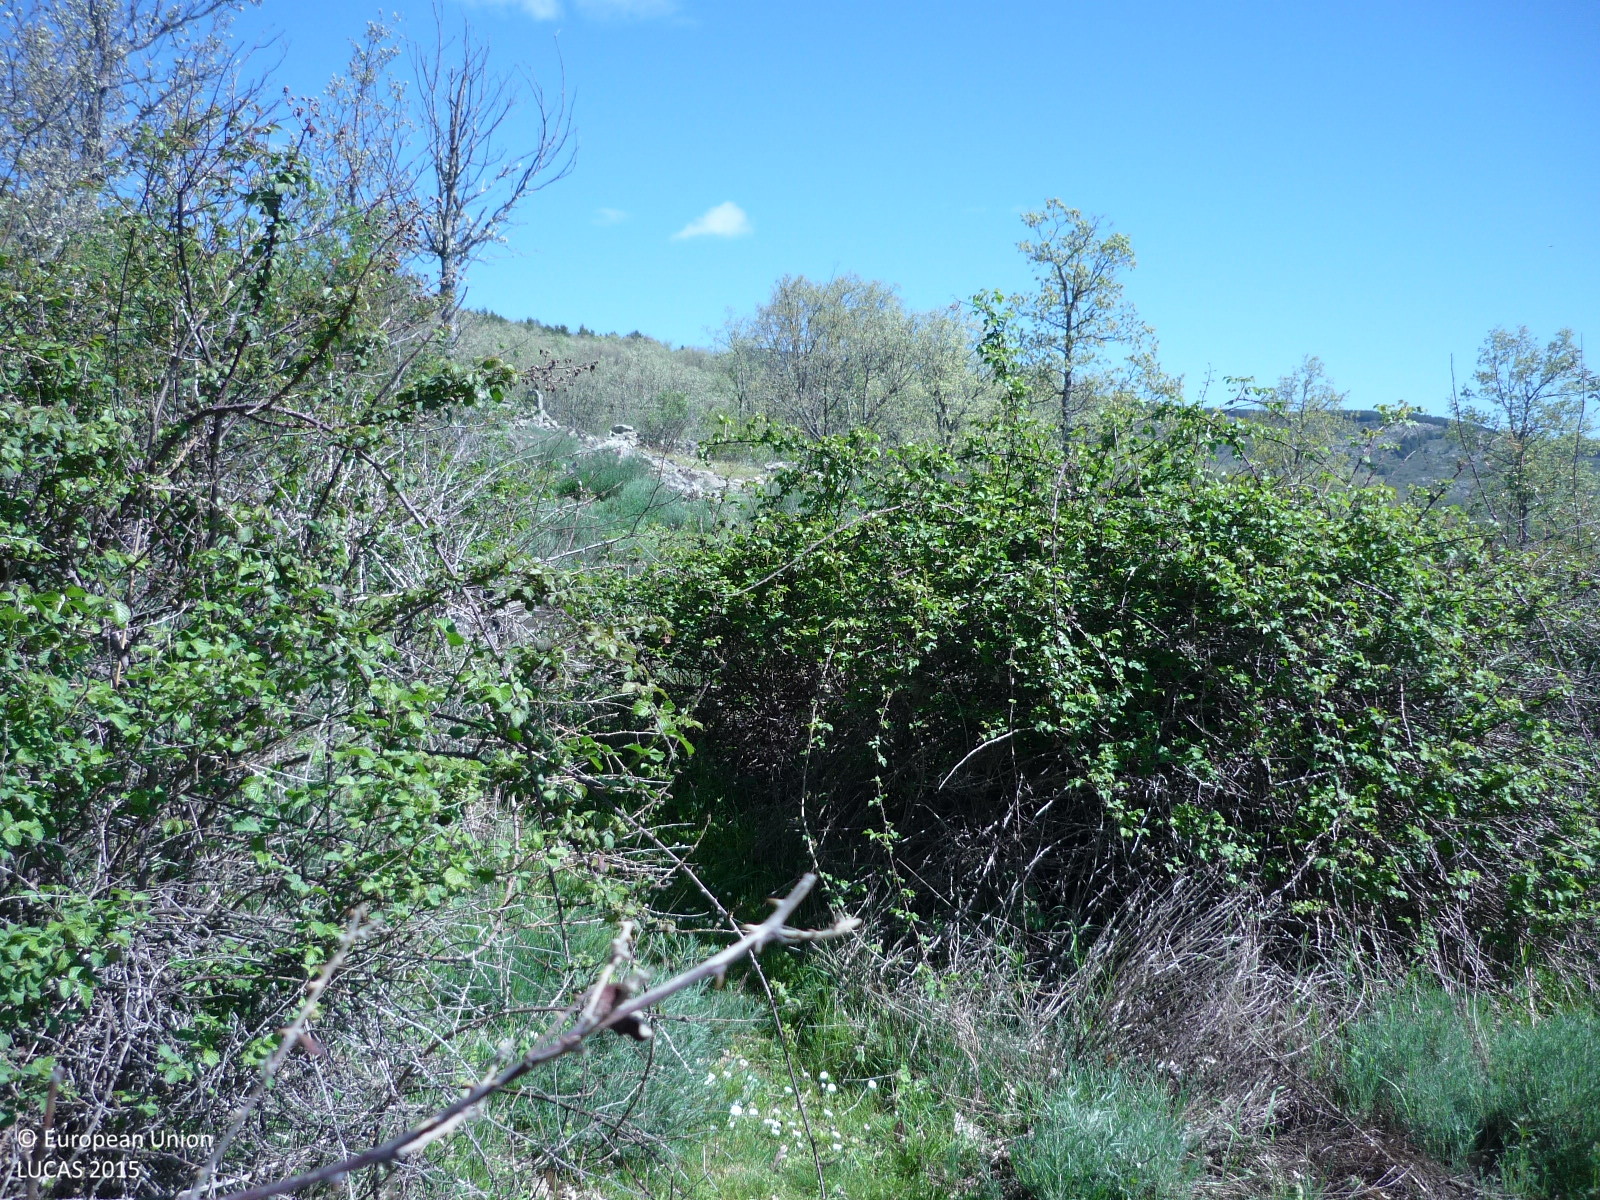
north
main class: Woodland
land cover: Broadleaved woodland
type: thermophilous deciduous forest
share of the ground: 50 - 75 %
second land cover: Grassland without tree/shrub cover
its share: 50 - 75 %
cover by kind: broadleaved forest trees 65 %, shrubs 20 %, herbaceous plants 15 %
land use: Forestry
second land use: Agriculture (excluding fallow land and kitchen gardens)
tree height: < 5 m
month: May
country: ES
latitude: 41.0215
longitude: -3.7096
